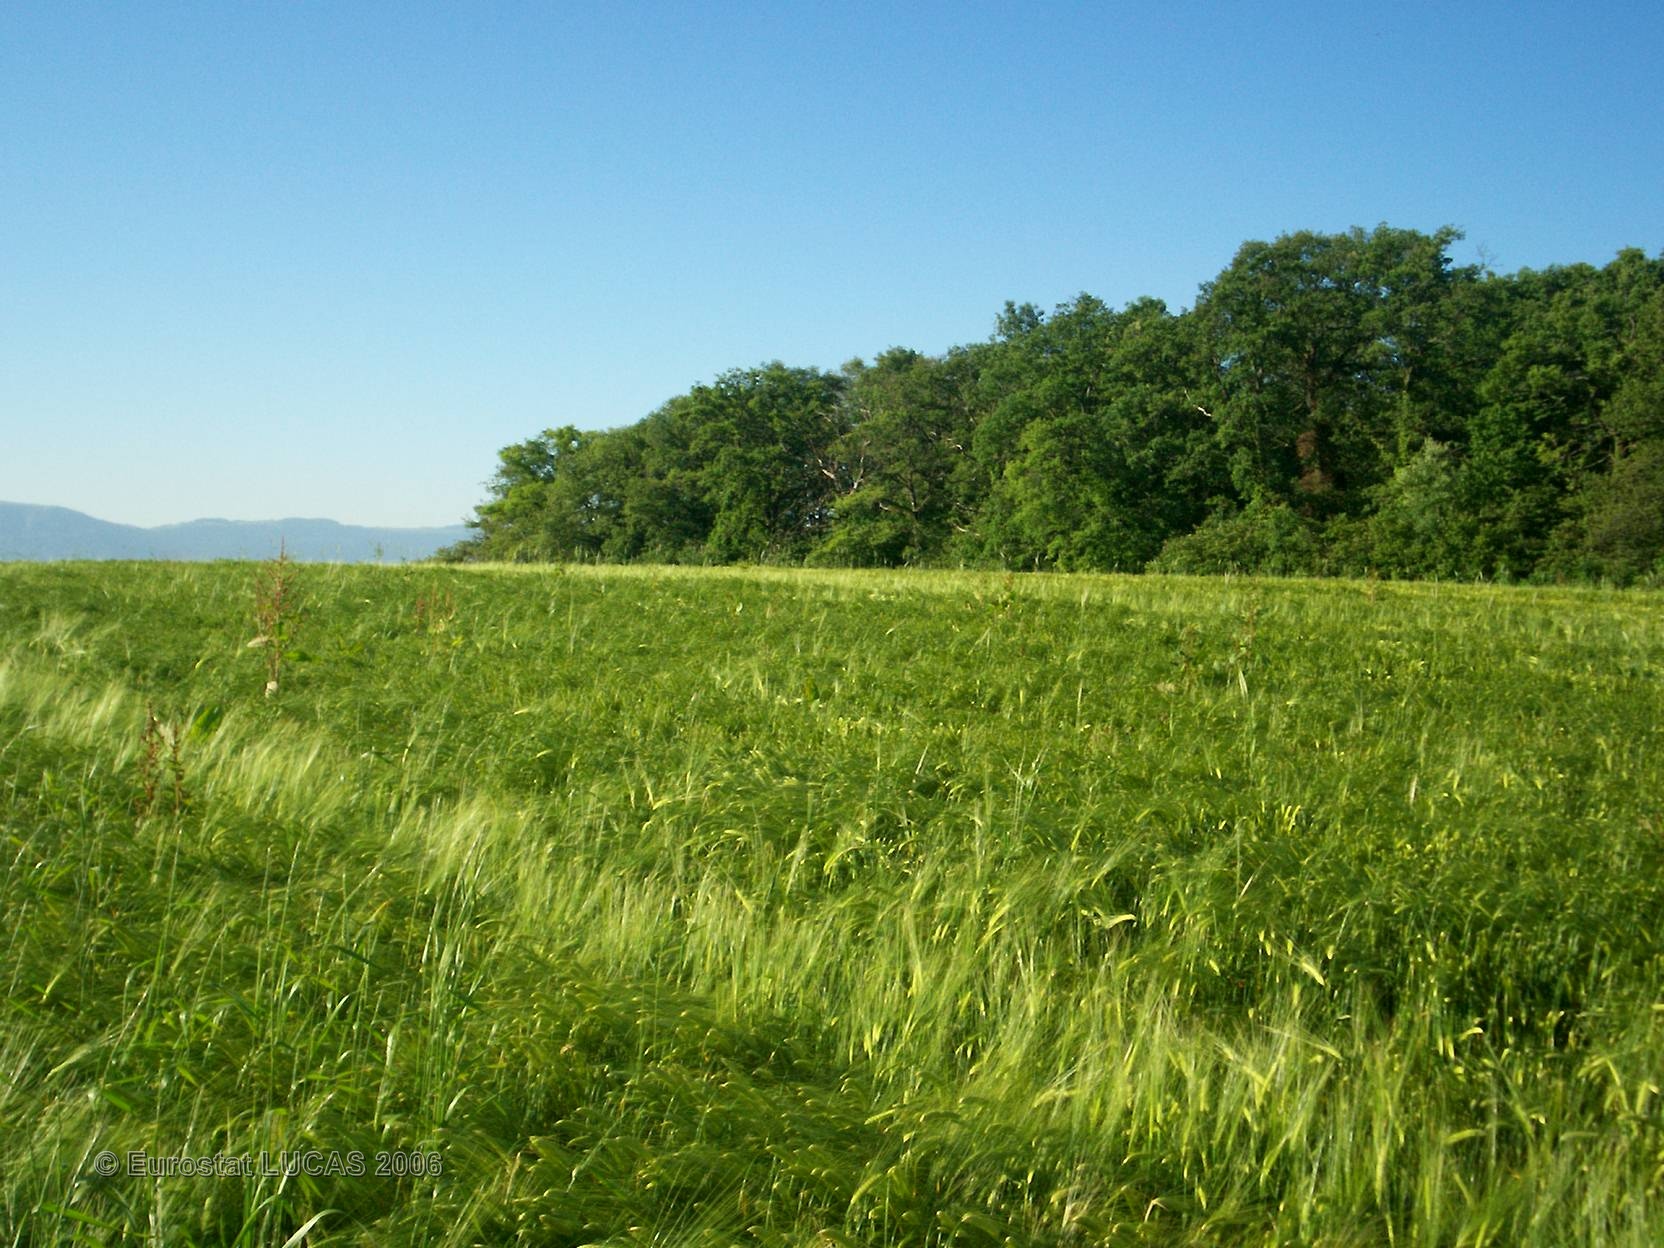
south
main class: Cropland
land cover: Barley
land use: Agriculture (excluding fallow land and kitchen gardens)
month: June
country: FR
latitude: 46.2441
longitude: 6.0995
